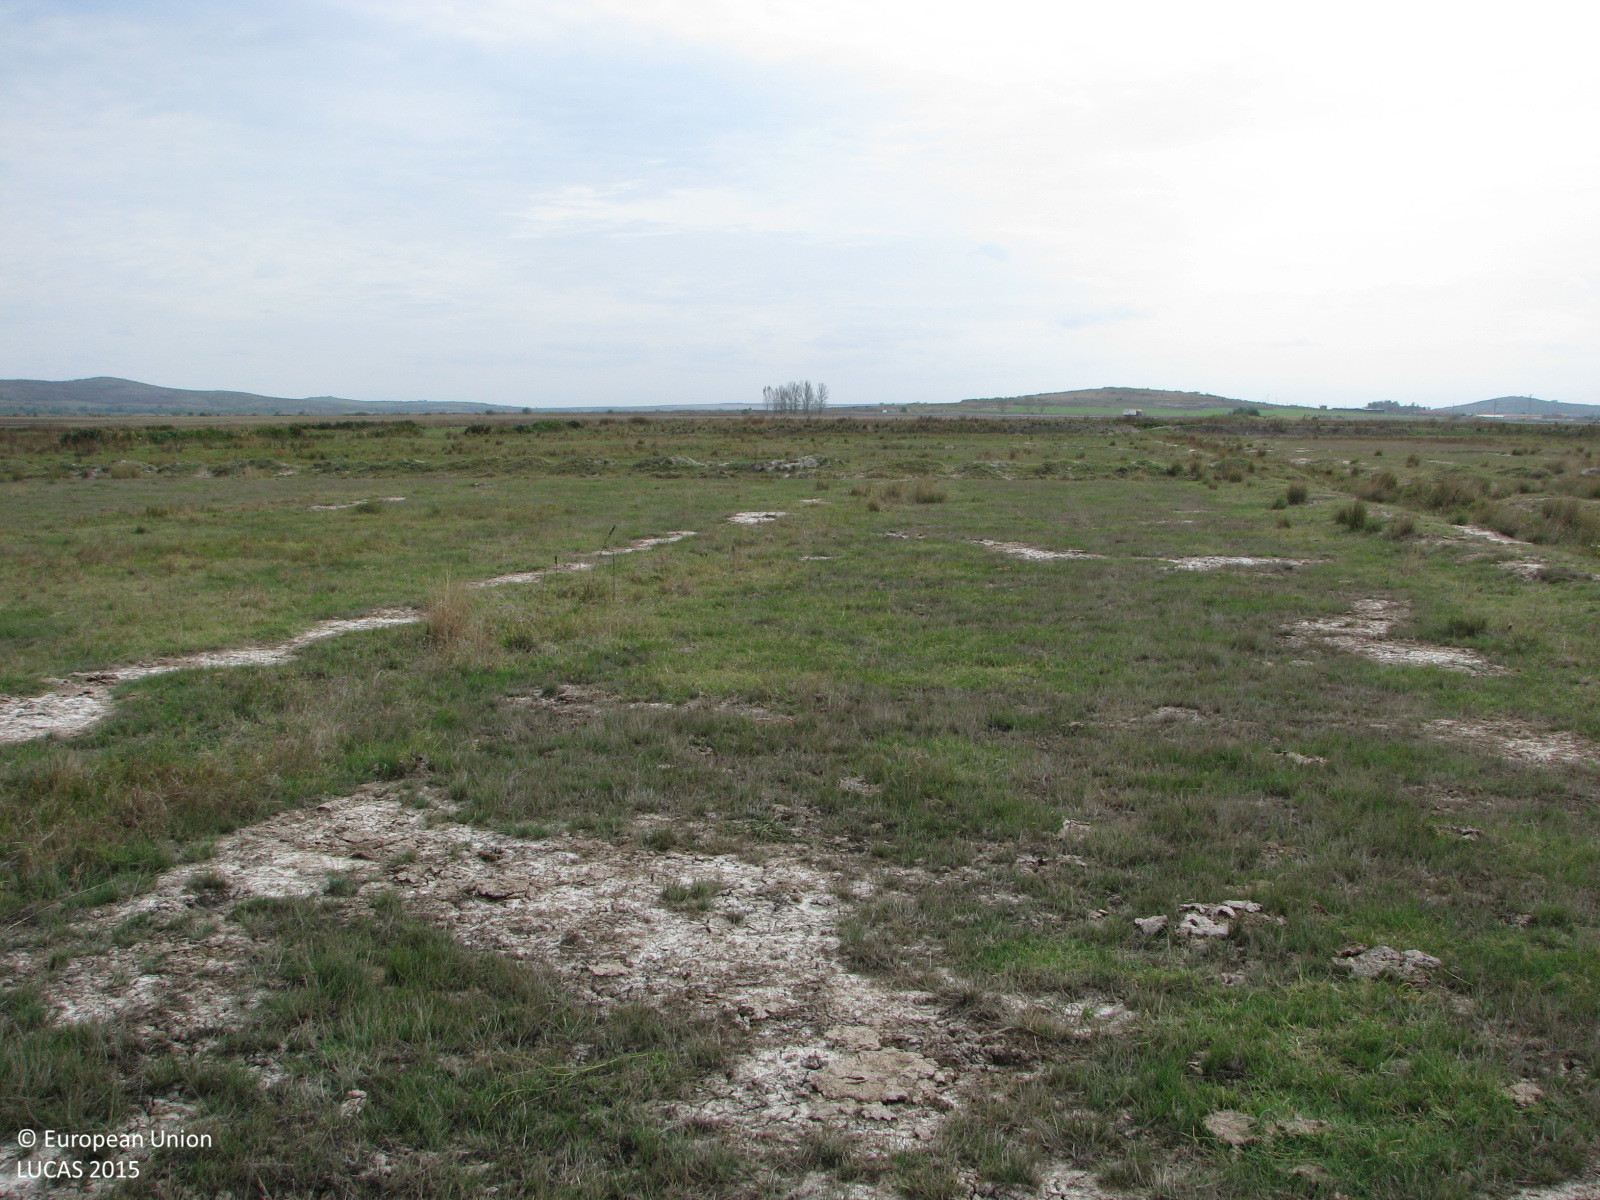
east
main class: Grassland
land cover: Grassland without tree/shrub cover
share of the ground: > 75 %
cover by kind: herbaceous plants 95 %, unconsolidated bare surface 5 %
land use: Agriculture (excluding fallow land and kitchen gardens)
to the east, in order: Grassland without tree/shrub cover; Ditches and canals; Grassland without tree/shrub cover; Ditches and canals; Grassland without tree/shrub cover; Inland fresh running water; Grassland without tree/shrub cover; Inland fresh running water; Grassland without tree/shrub cover; Inland marshes
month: October
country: BG
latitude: 42.5024
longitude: 26.2842
